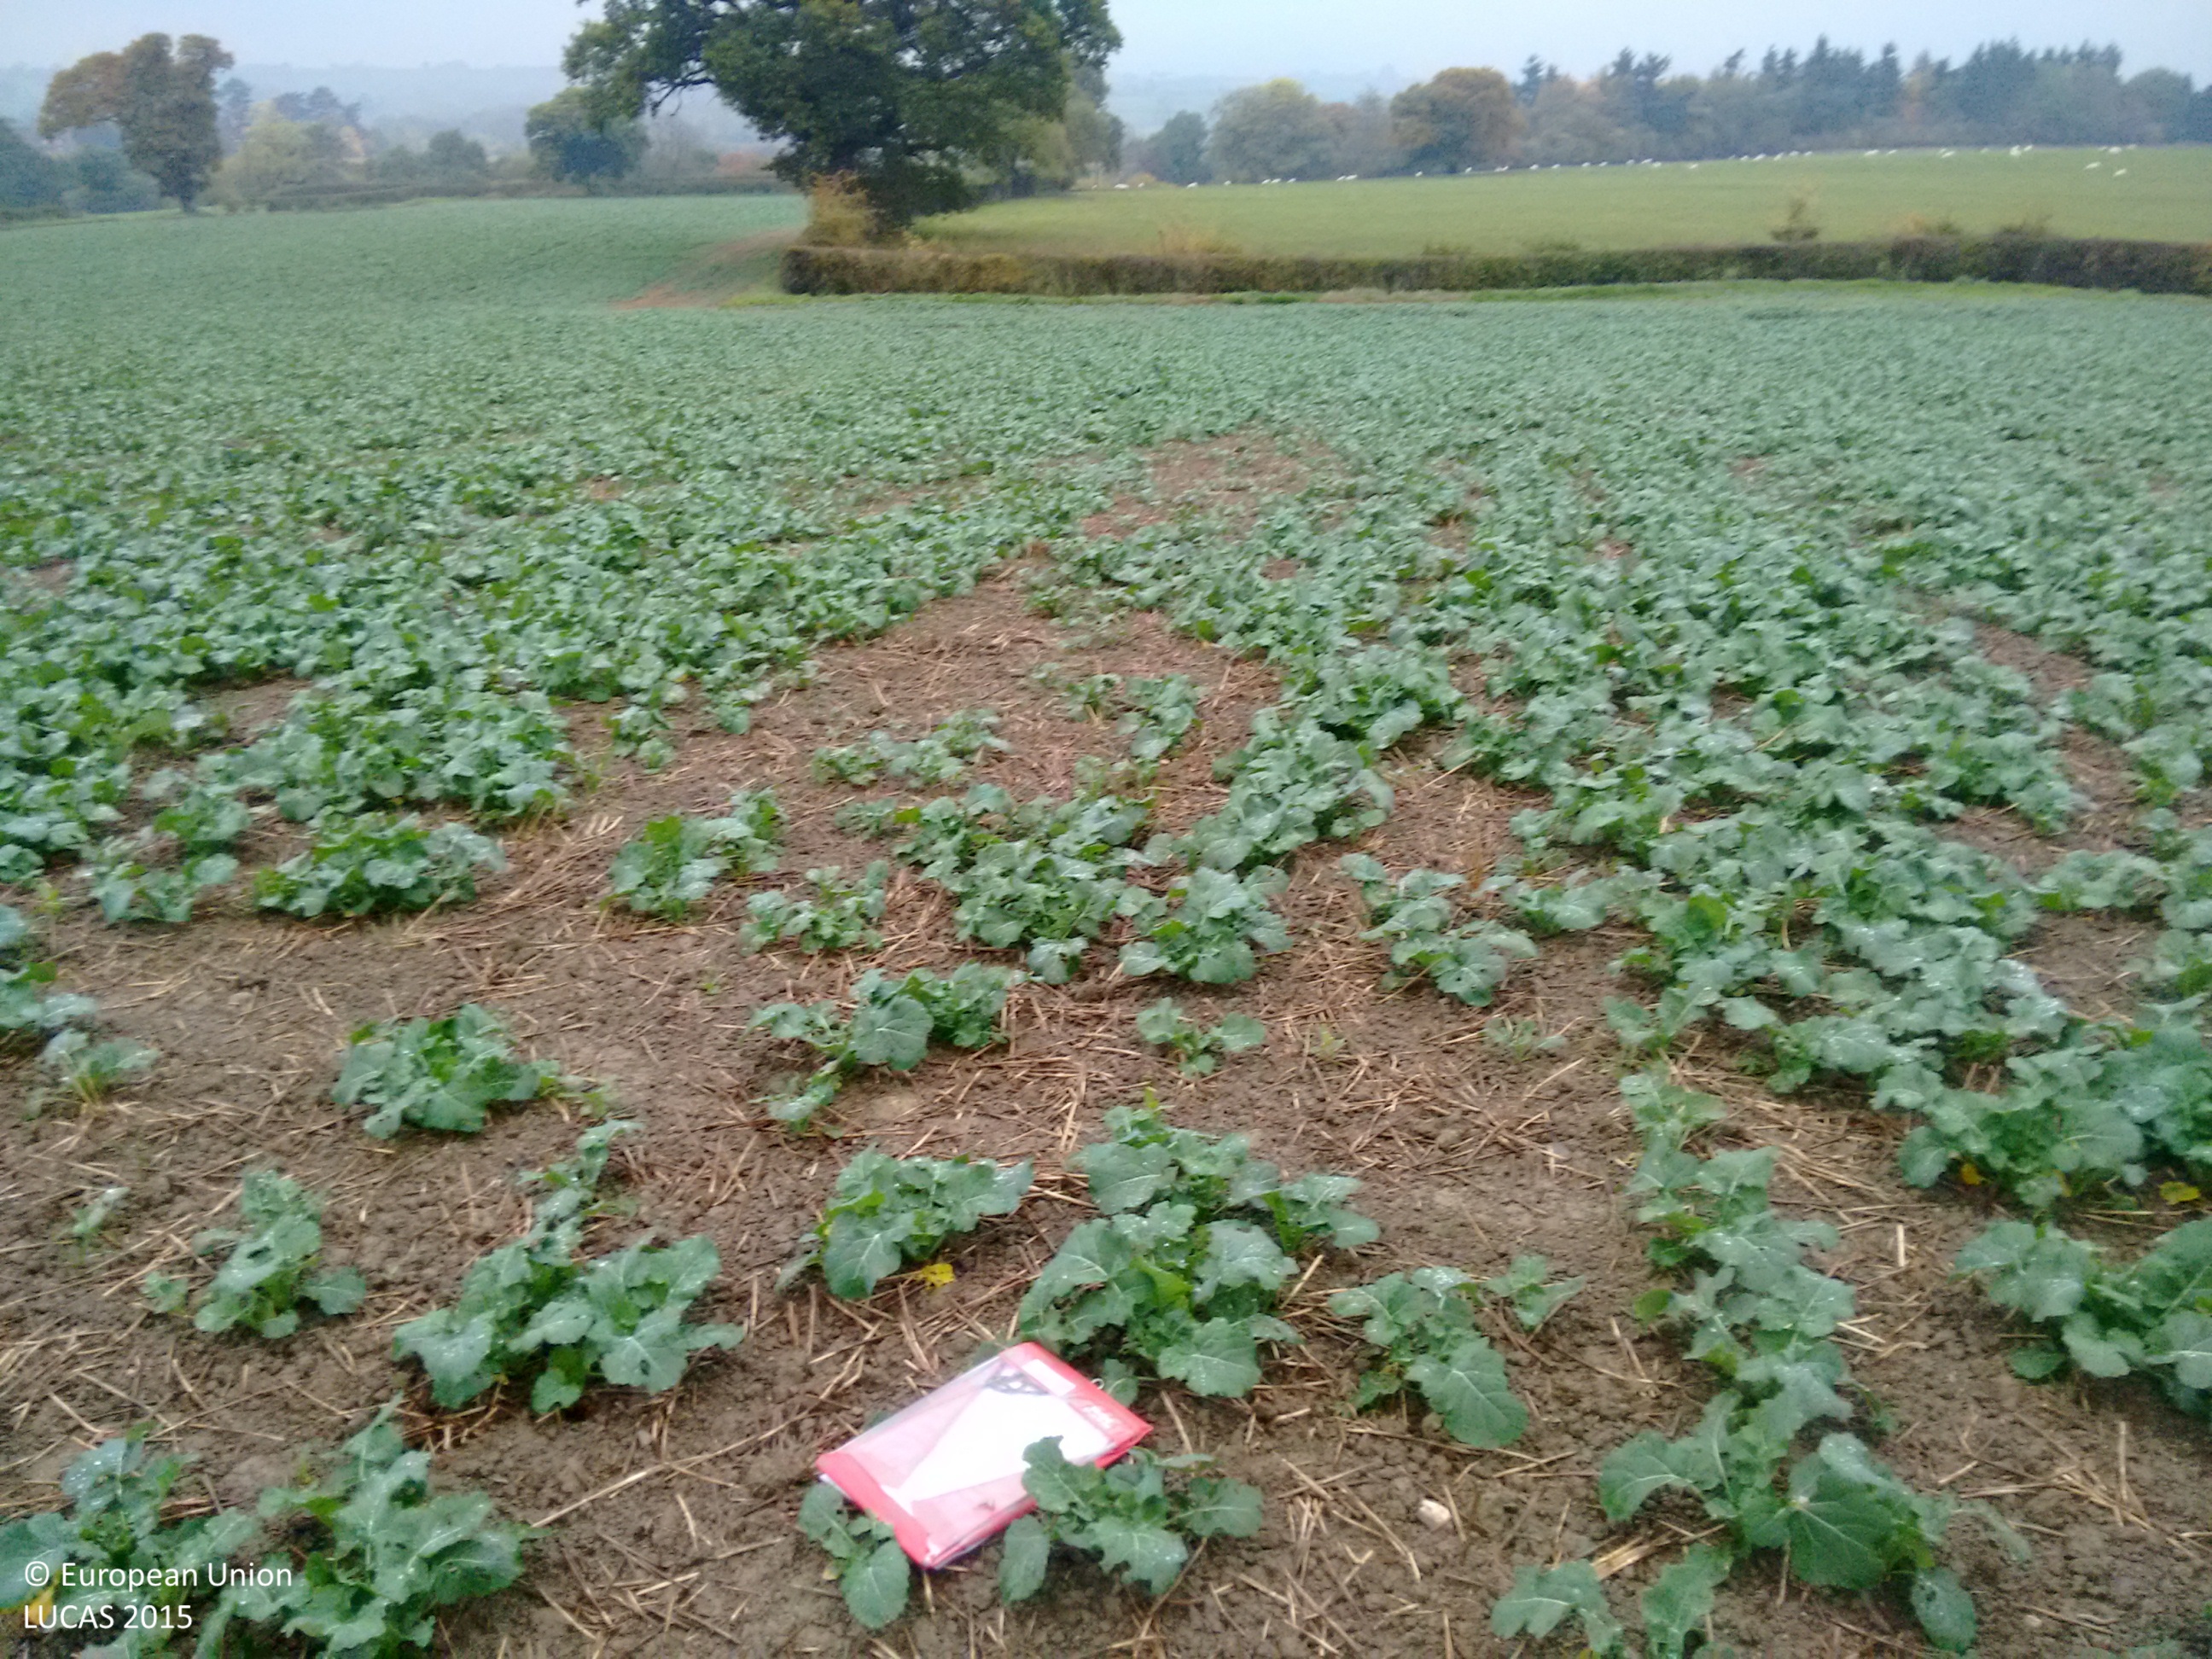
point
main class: Cropland
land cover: Rape and turnip rape
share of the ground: > 75 %
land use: Agriculture (excluding fallow land and kitchen gardens)
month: October
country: GB
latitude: 52.4814
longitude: -2.8083
